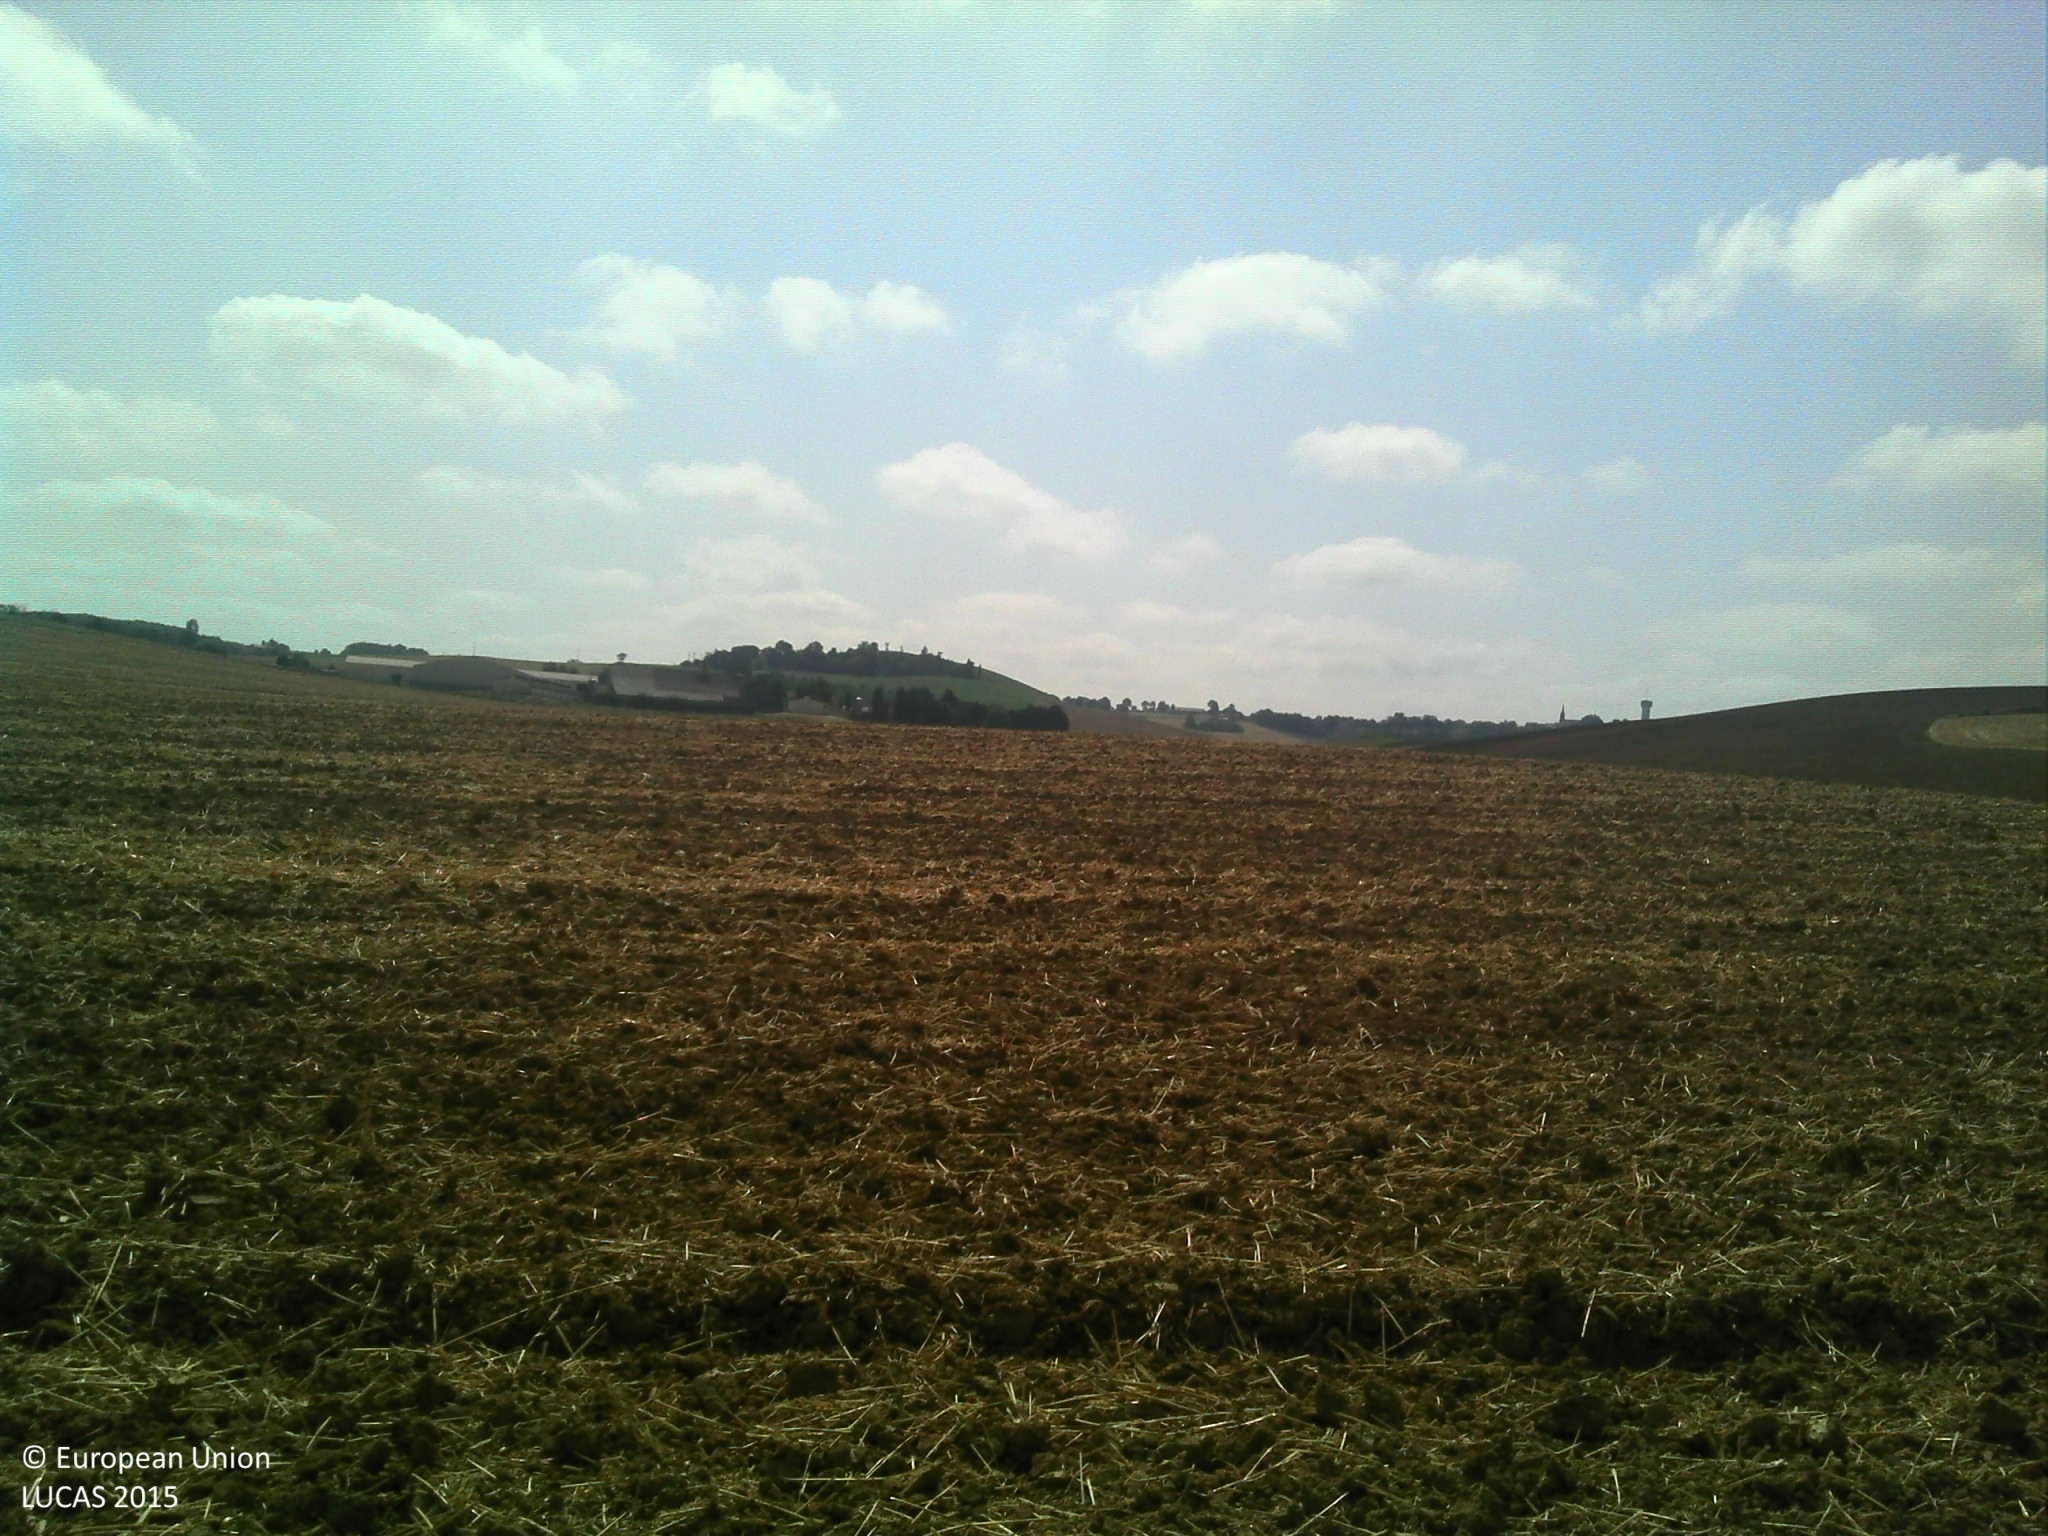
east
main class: Cropland
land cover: Common wheat
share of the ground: < 10 %
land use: Agriculture (excluding fallow land and kitchen gardens)
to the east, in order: Common wheat
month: July
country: FR
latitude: 43.8504
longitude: 1.0051
